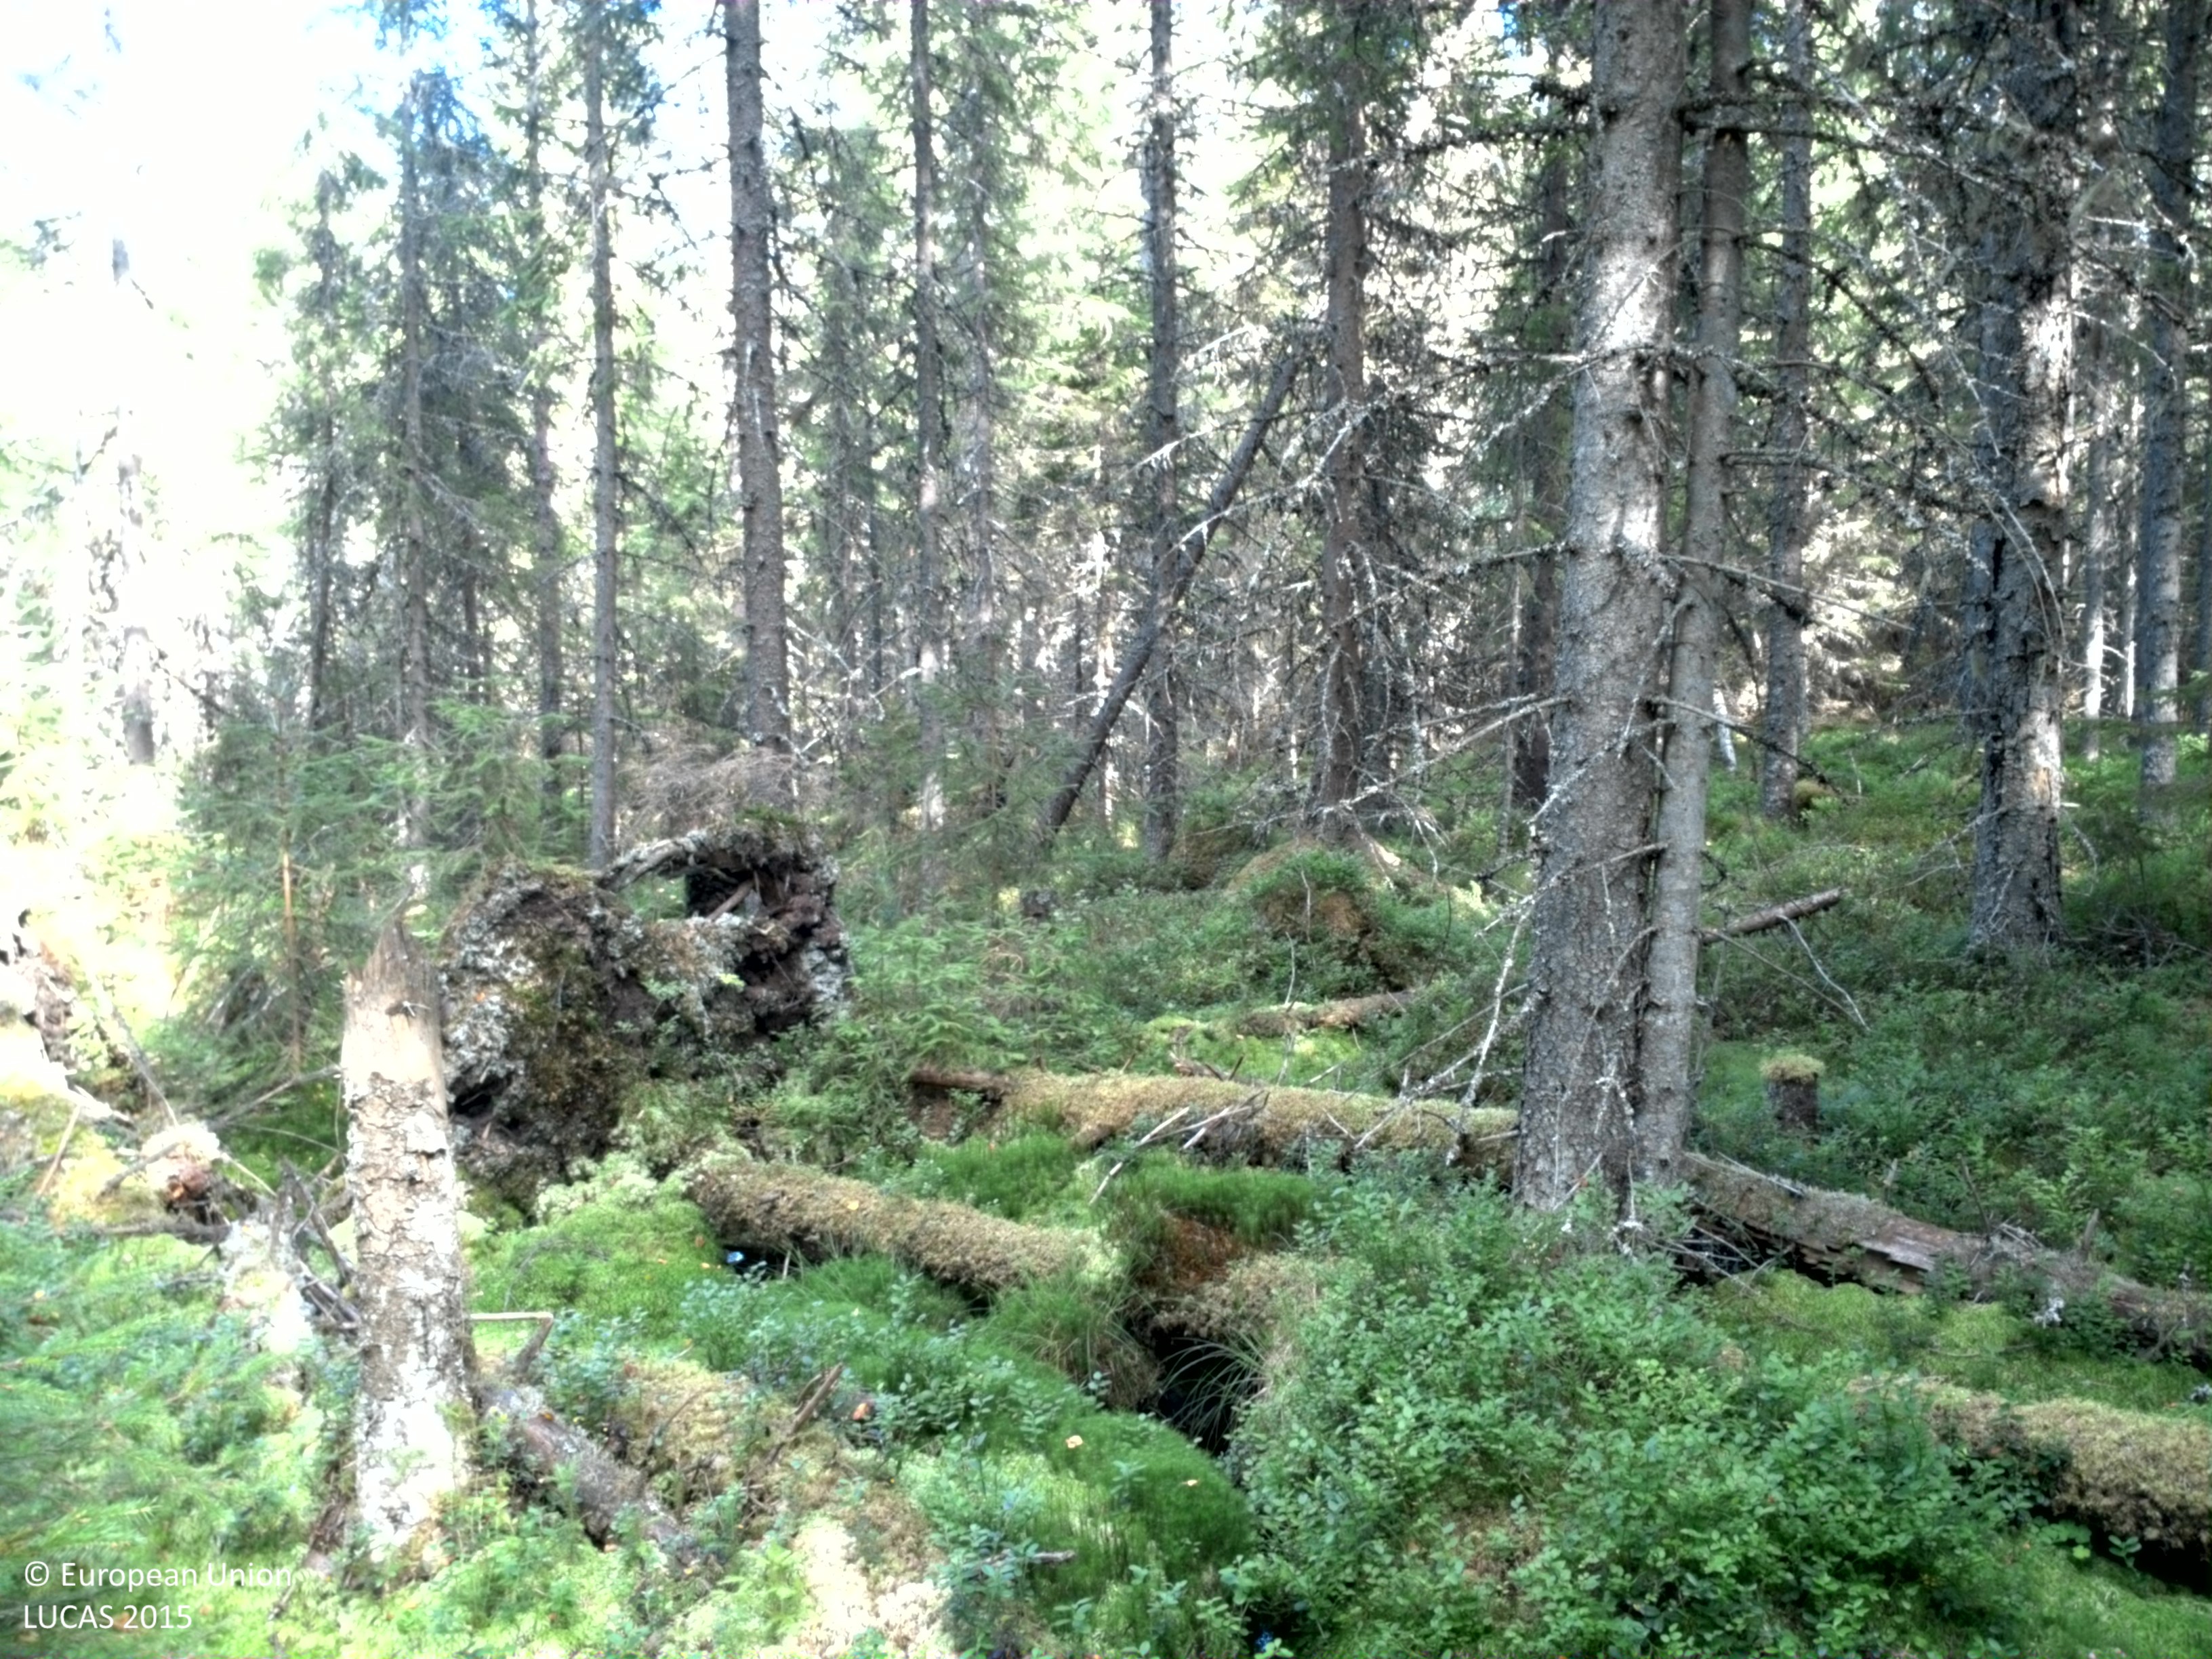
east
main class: Woodland
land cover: Spruce dominated coniferous woodland
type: boreal forest
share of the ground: 50 - 75 %
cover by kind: coniferous forest trees 65 %, shrubs 15 %, lichens and mosses 10 %, broadleaved forest trees 5 %, herbaceous plants 5 %
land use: Forestry
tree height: > 5 m
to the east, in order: Spruce dominated coniferous woodland; Rivers and streams; Spruce dominated coniferous woodland; Rivers and streams; Spruce dominated mixed woodland; Pine dominated mixed woodland; Shrubland with sparse tree cover
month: August
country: SE
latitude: 60.2801
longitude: 13.5525
